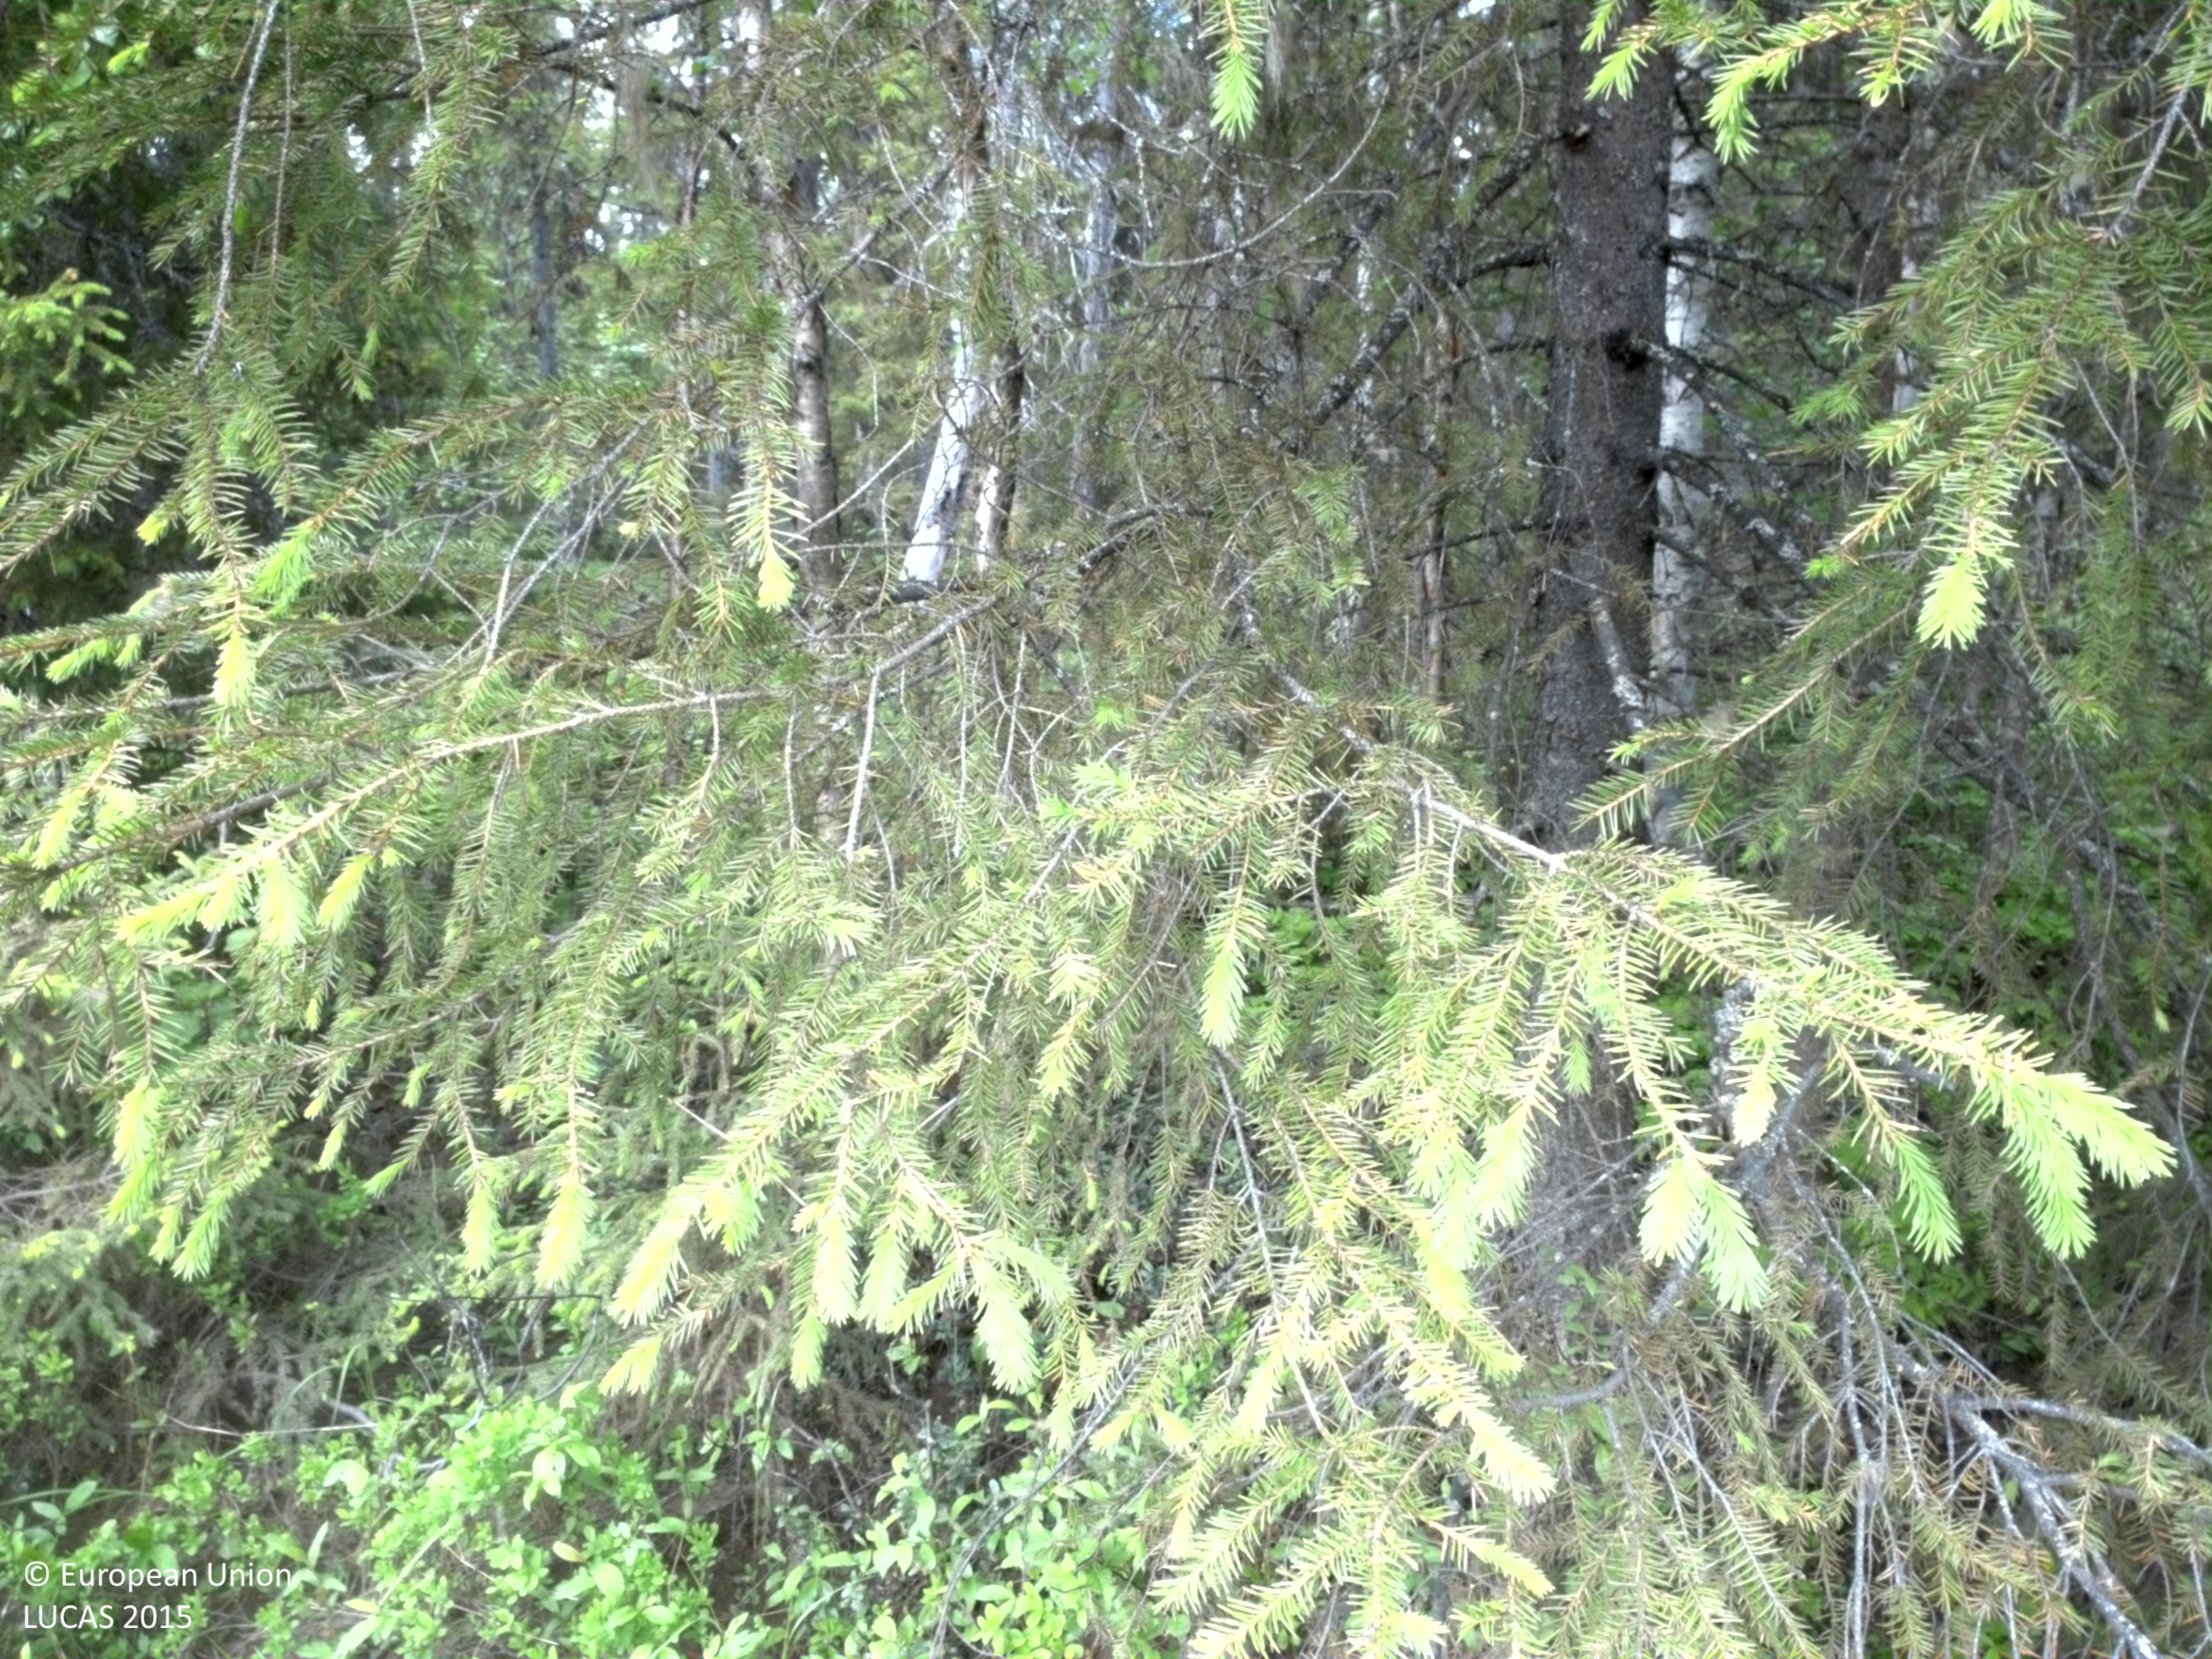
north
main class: Woodland
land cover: Spruce dominated mixed woodland
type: boreal forest
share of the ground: 50 - 75 %
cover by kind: shrubs 40 %, coniferous forest trees 35 %, broadleaved forest trees 25 %
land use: Forestry
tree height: > 5 m
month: June
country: SE
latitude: 66.4264
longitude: 22.3628
